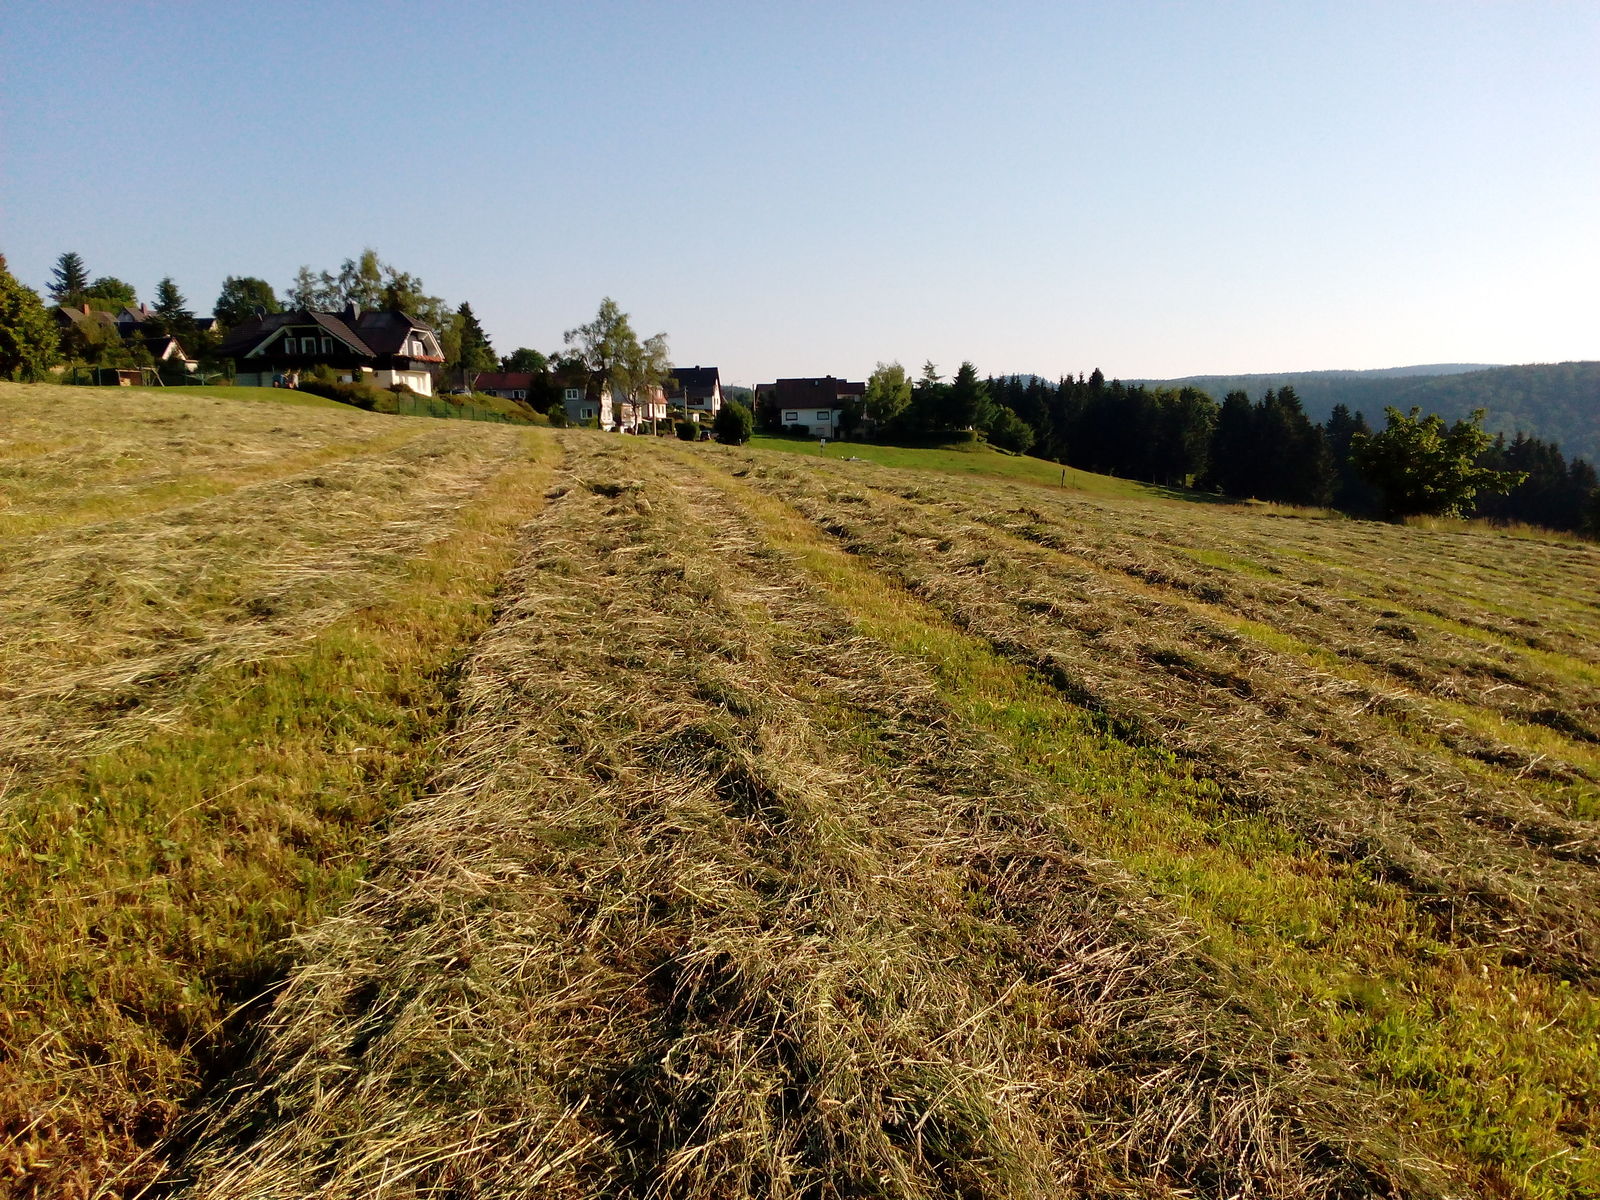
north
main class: Grassland
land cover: Grassland without tree/shrub cover
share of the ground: > 75 %
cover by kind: herbaceous plants 100 %
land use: Agriculture (excluding fallow land and kitchen gardens)
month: July
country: DE
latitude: 50.5766
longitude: 10.8611
